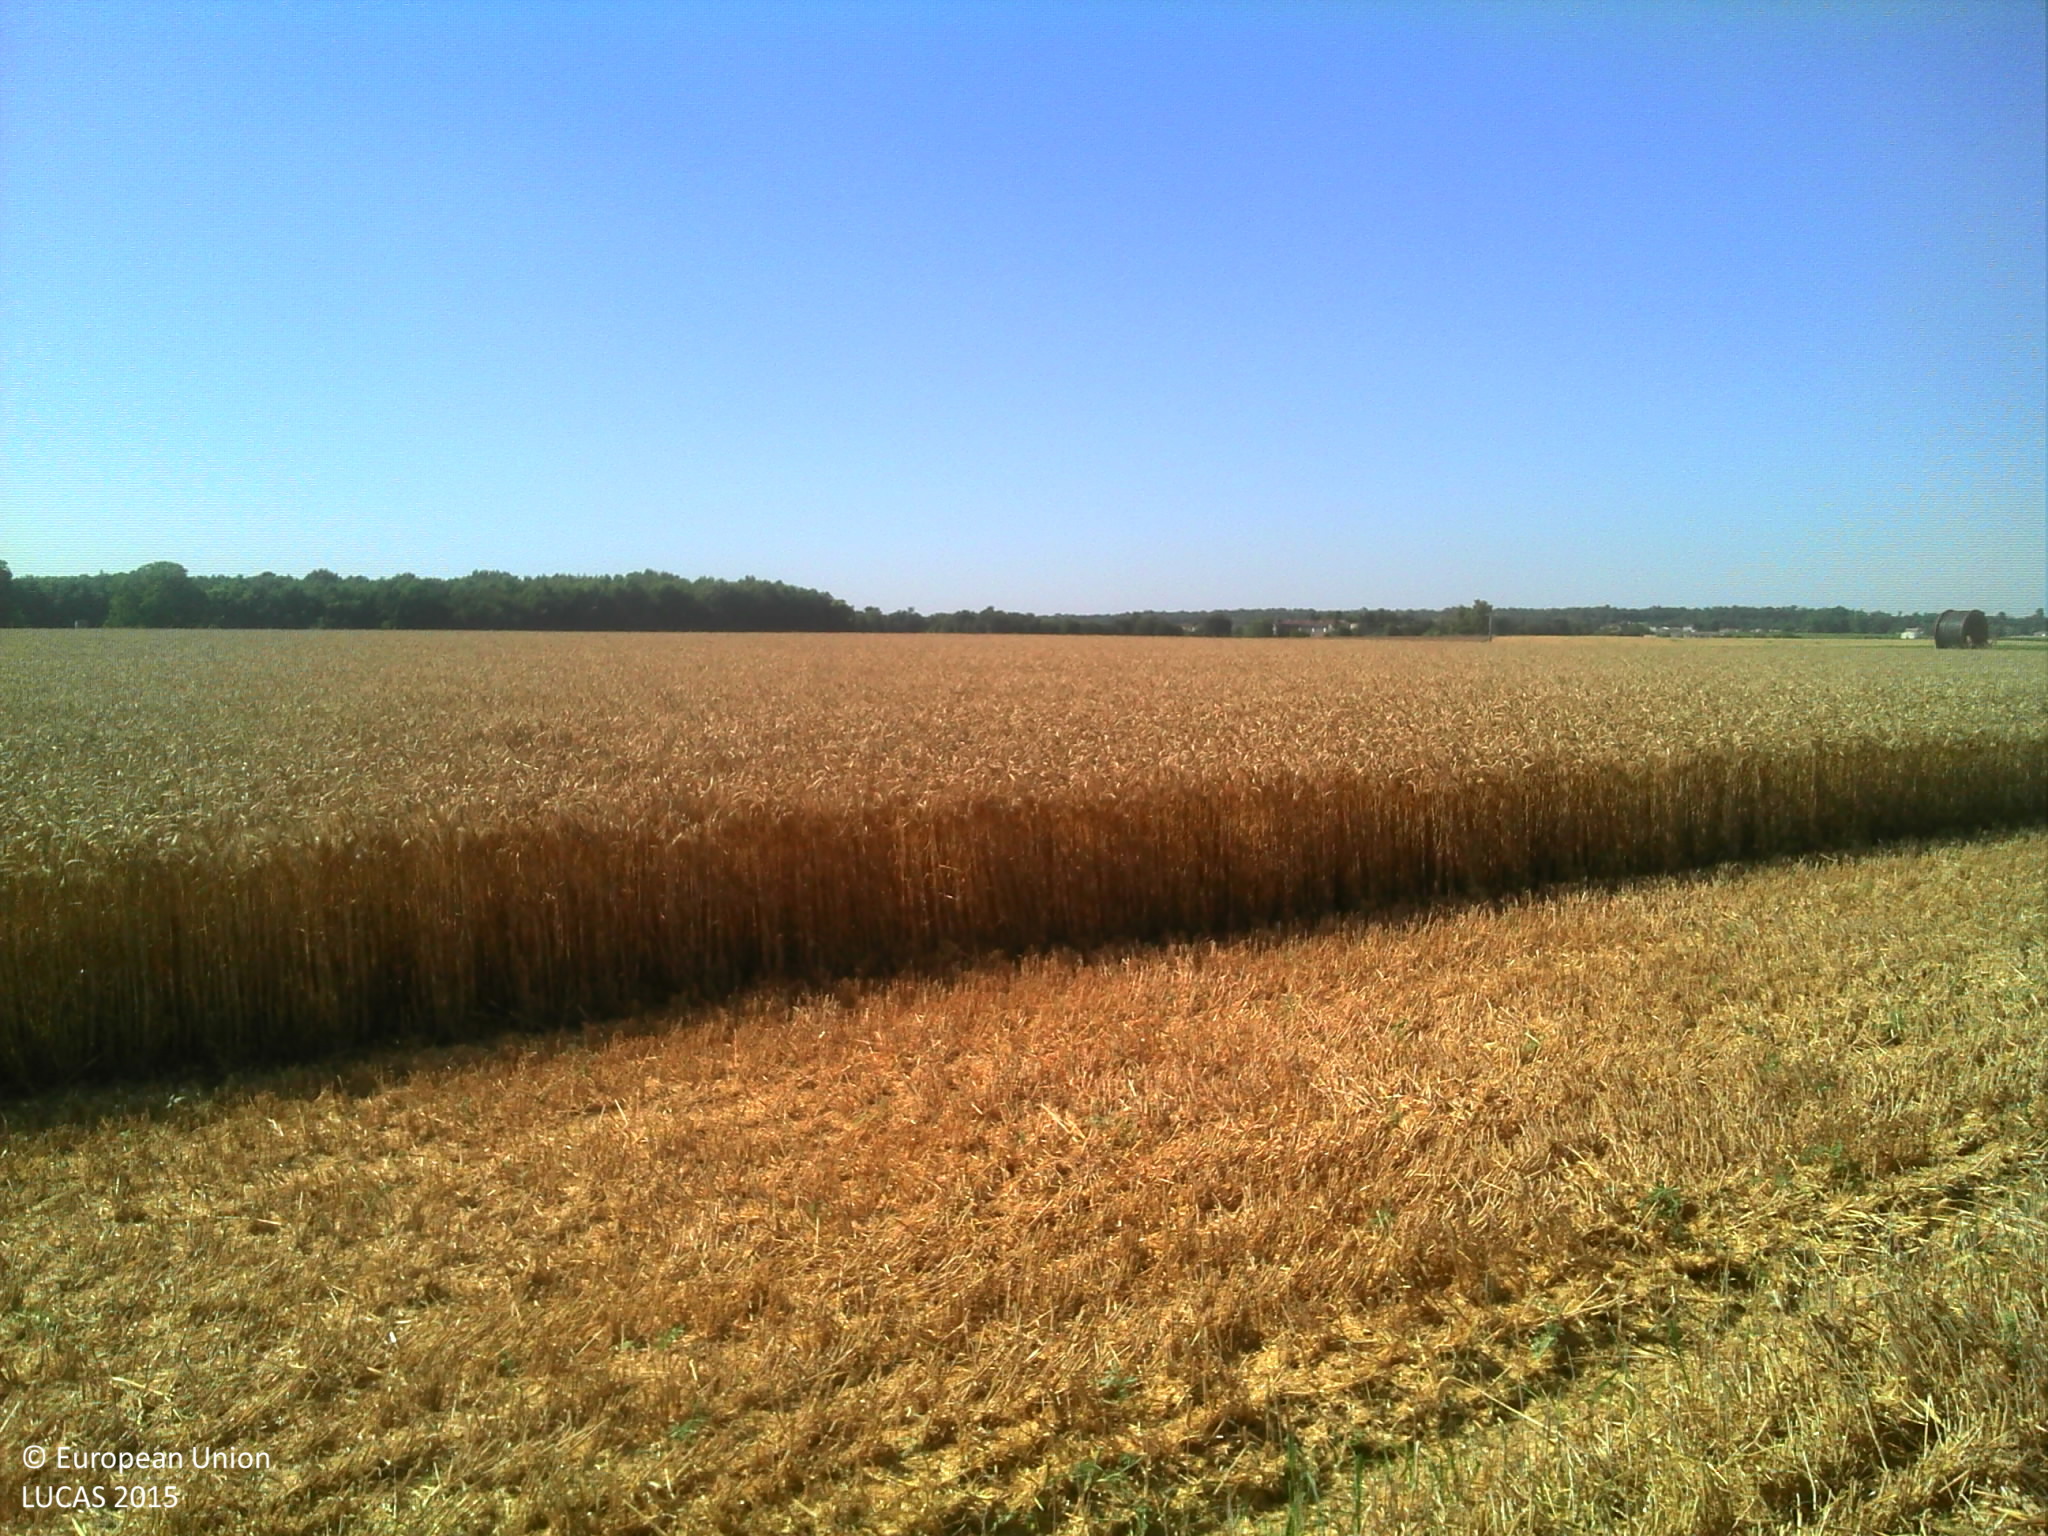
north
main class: Cropland
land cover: Common wheat
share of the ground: > 75 %
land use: Agriculture (excluding fallow land and kitchen gardens)
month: June
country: FR
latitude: 45.5846
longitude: -0.6227
